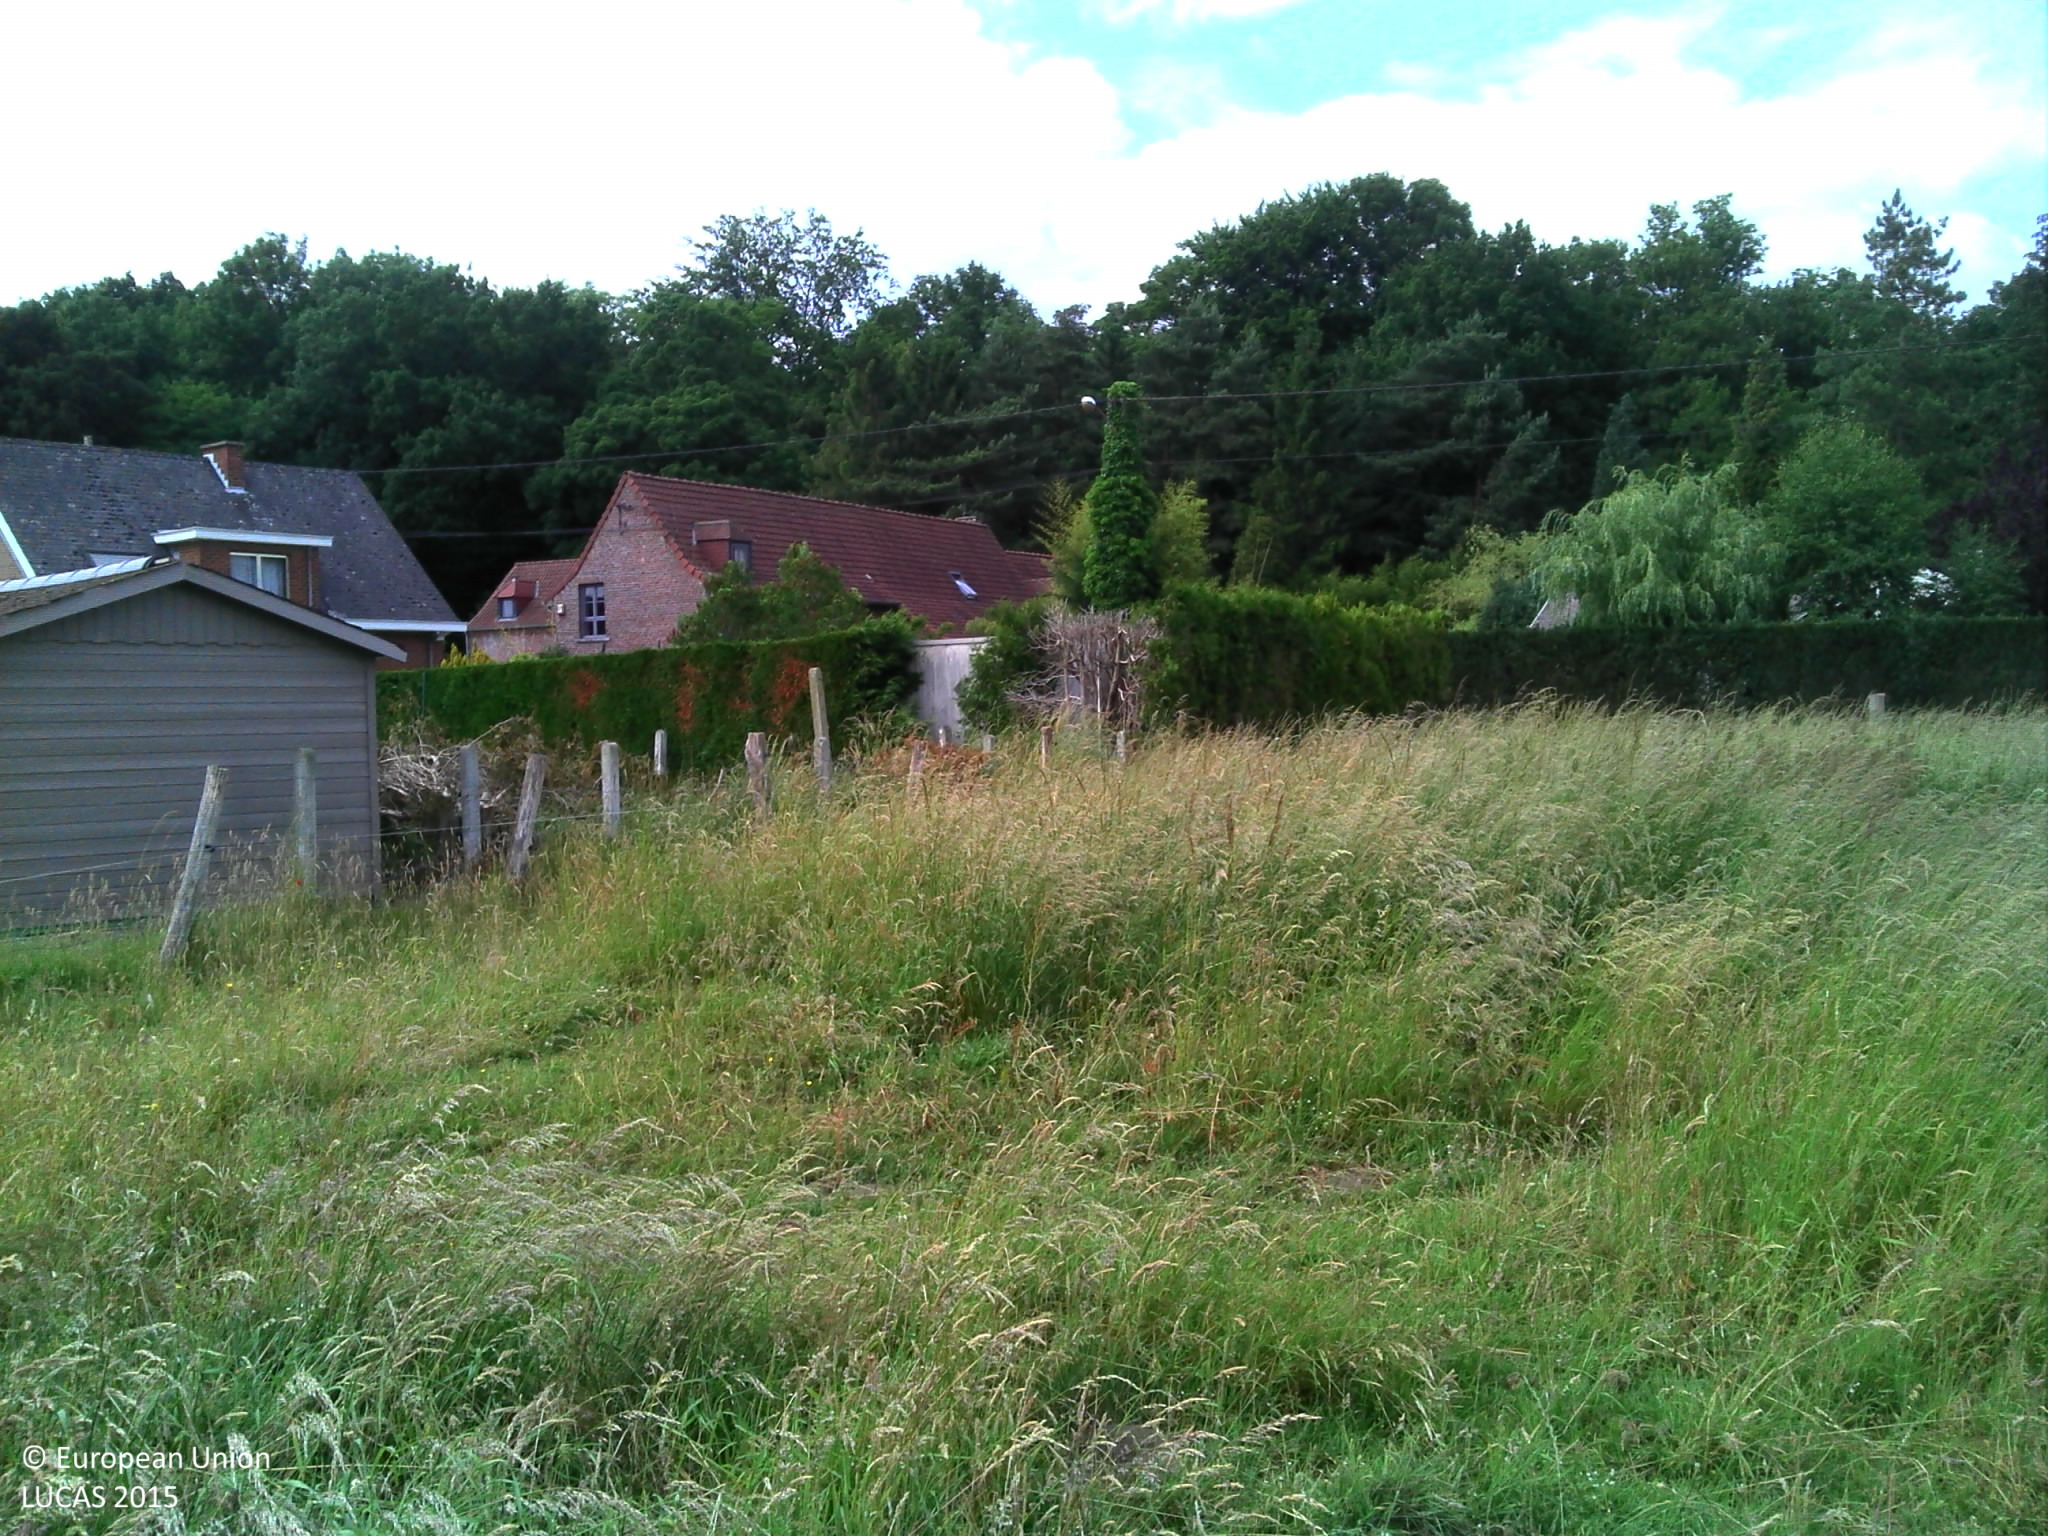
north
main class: Grassland
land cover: Grassland without tree/shrub cover
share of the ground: > 75 %
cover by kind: herbaceous plants 100 %
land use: Agriculture (excluding fallow land and kitchen gardens)
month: June
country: BE
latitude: 50.4908
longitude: 3.9187
